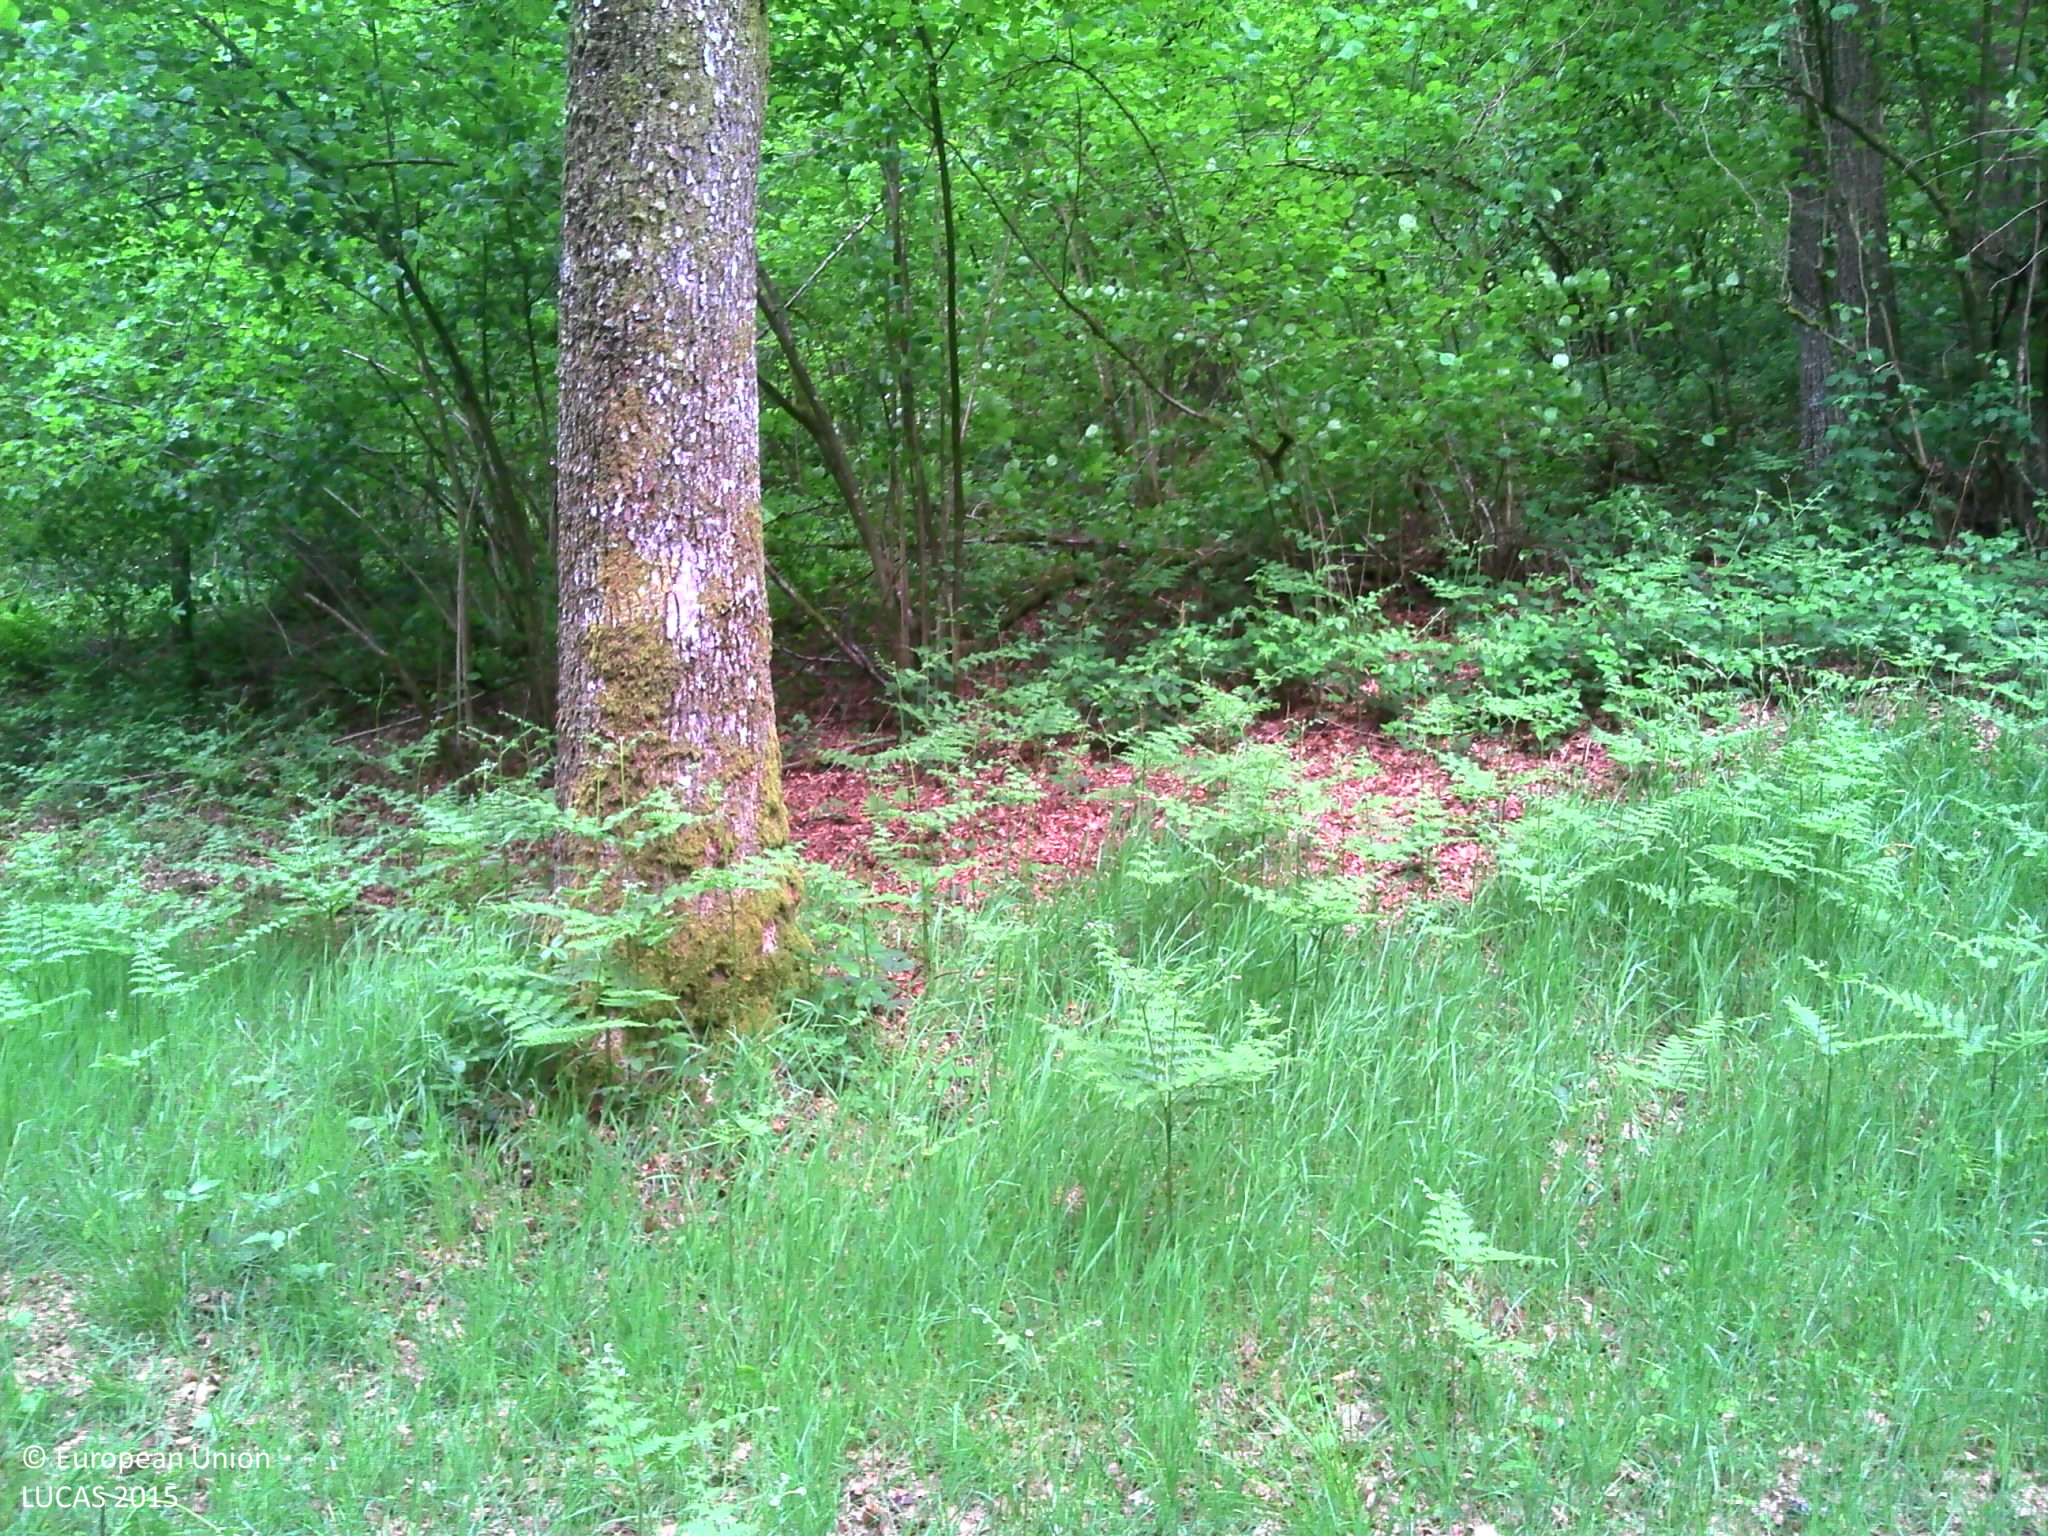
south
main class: Woodland
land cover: Broadleaved woodland
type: mesophytic deciduous forest
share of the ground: > 75 %
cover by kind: broadleaved forest trees 90 %, herbaceous plants 10 %
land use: Forestry
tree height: > 5 m
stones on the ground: < 10 %
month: June
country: BE
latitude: 50.4243
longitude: 5.6209
